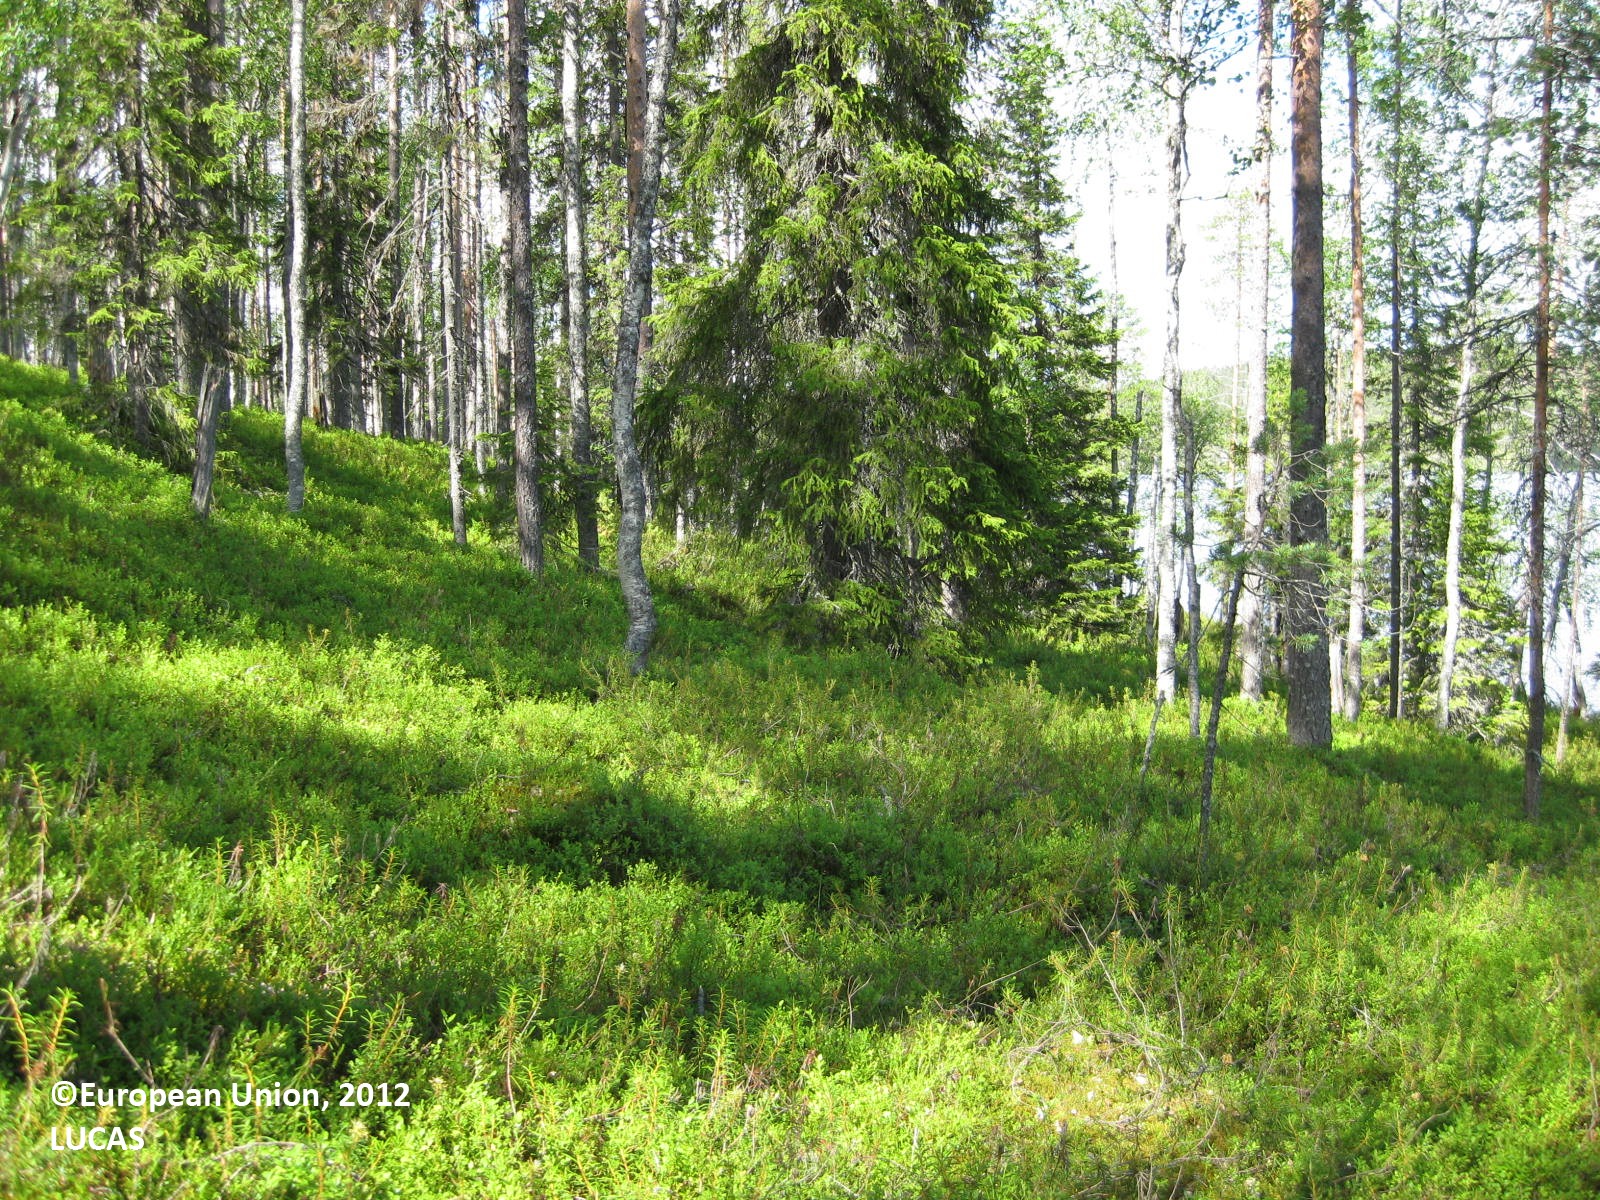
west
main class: Woodland
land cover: Pine dominated mixed woodland
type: boreal forest
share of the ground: > 75 %
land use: Forestry
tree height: > 5 m
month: July
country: FI
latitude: 65.6936
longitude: 29.8707
